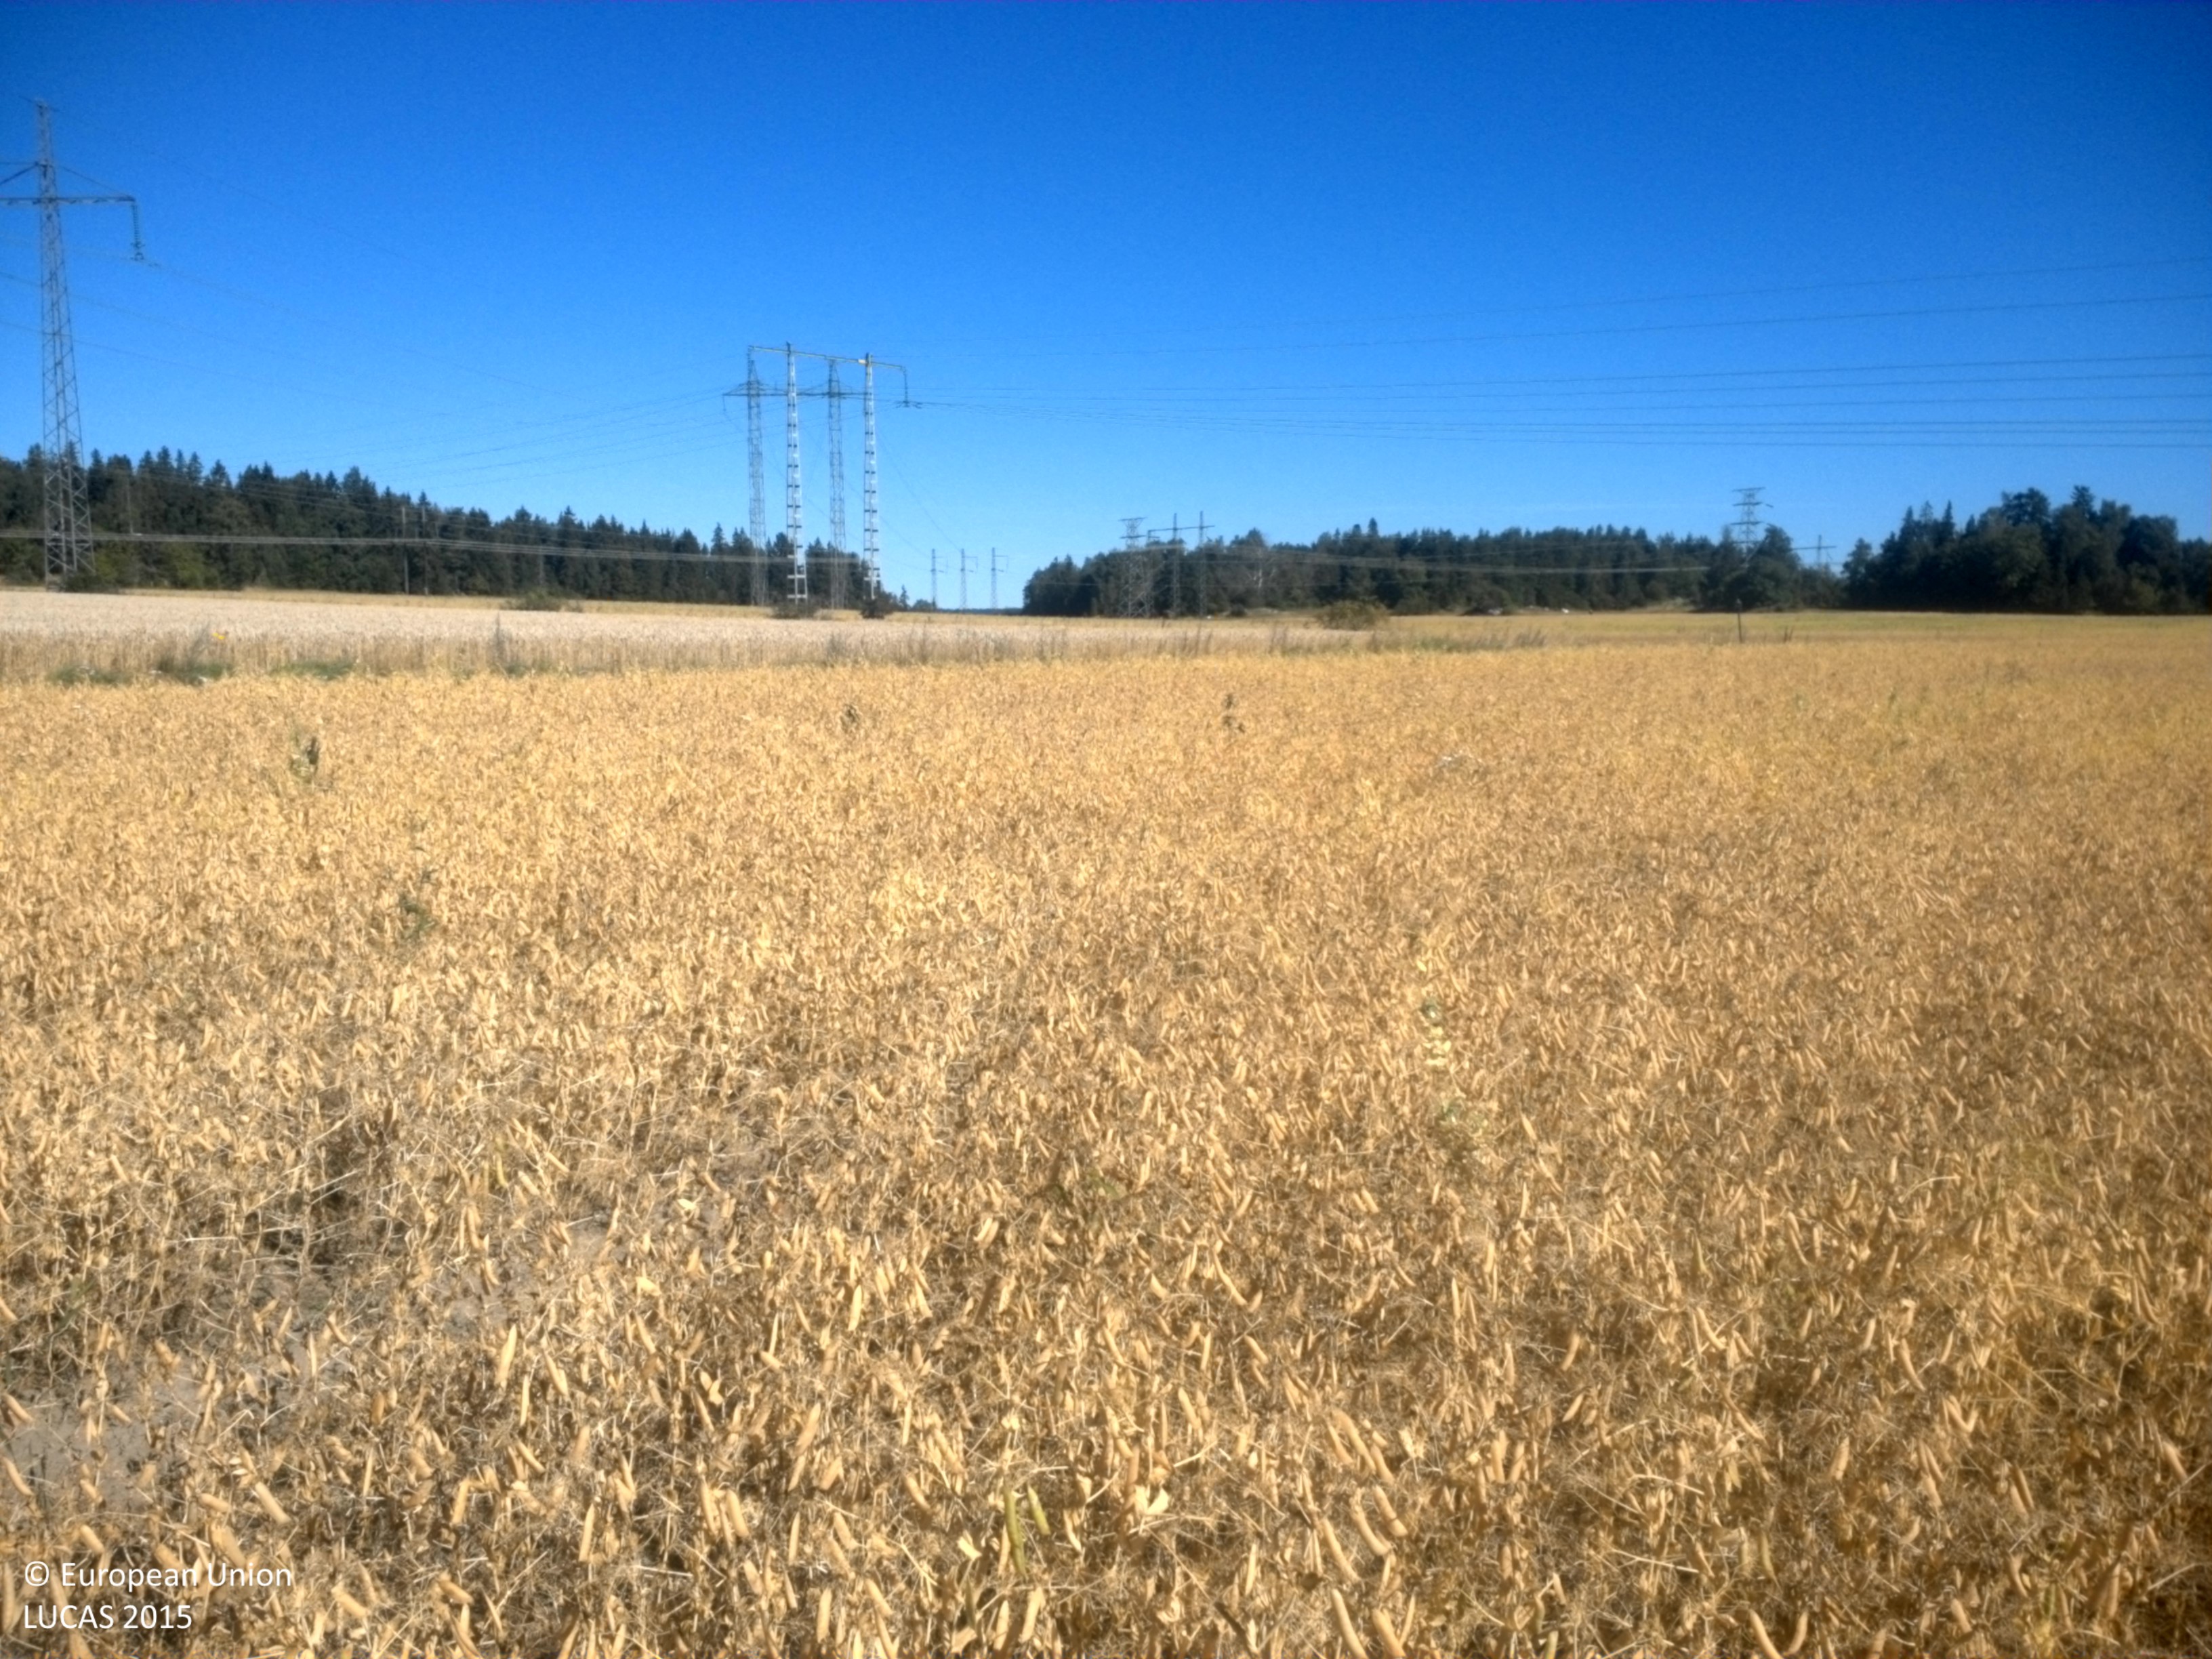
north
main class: Cropland
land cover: Dry pulses
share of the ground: > 75 %
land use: Agriculture (excluding fallow land and kitchen gardens)
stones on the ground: < 10 %
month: August
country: SE
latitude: 59.7239
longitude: 17.2309
